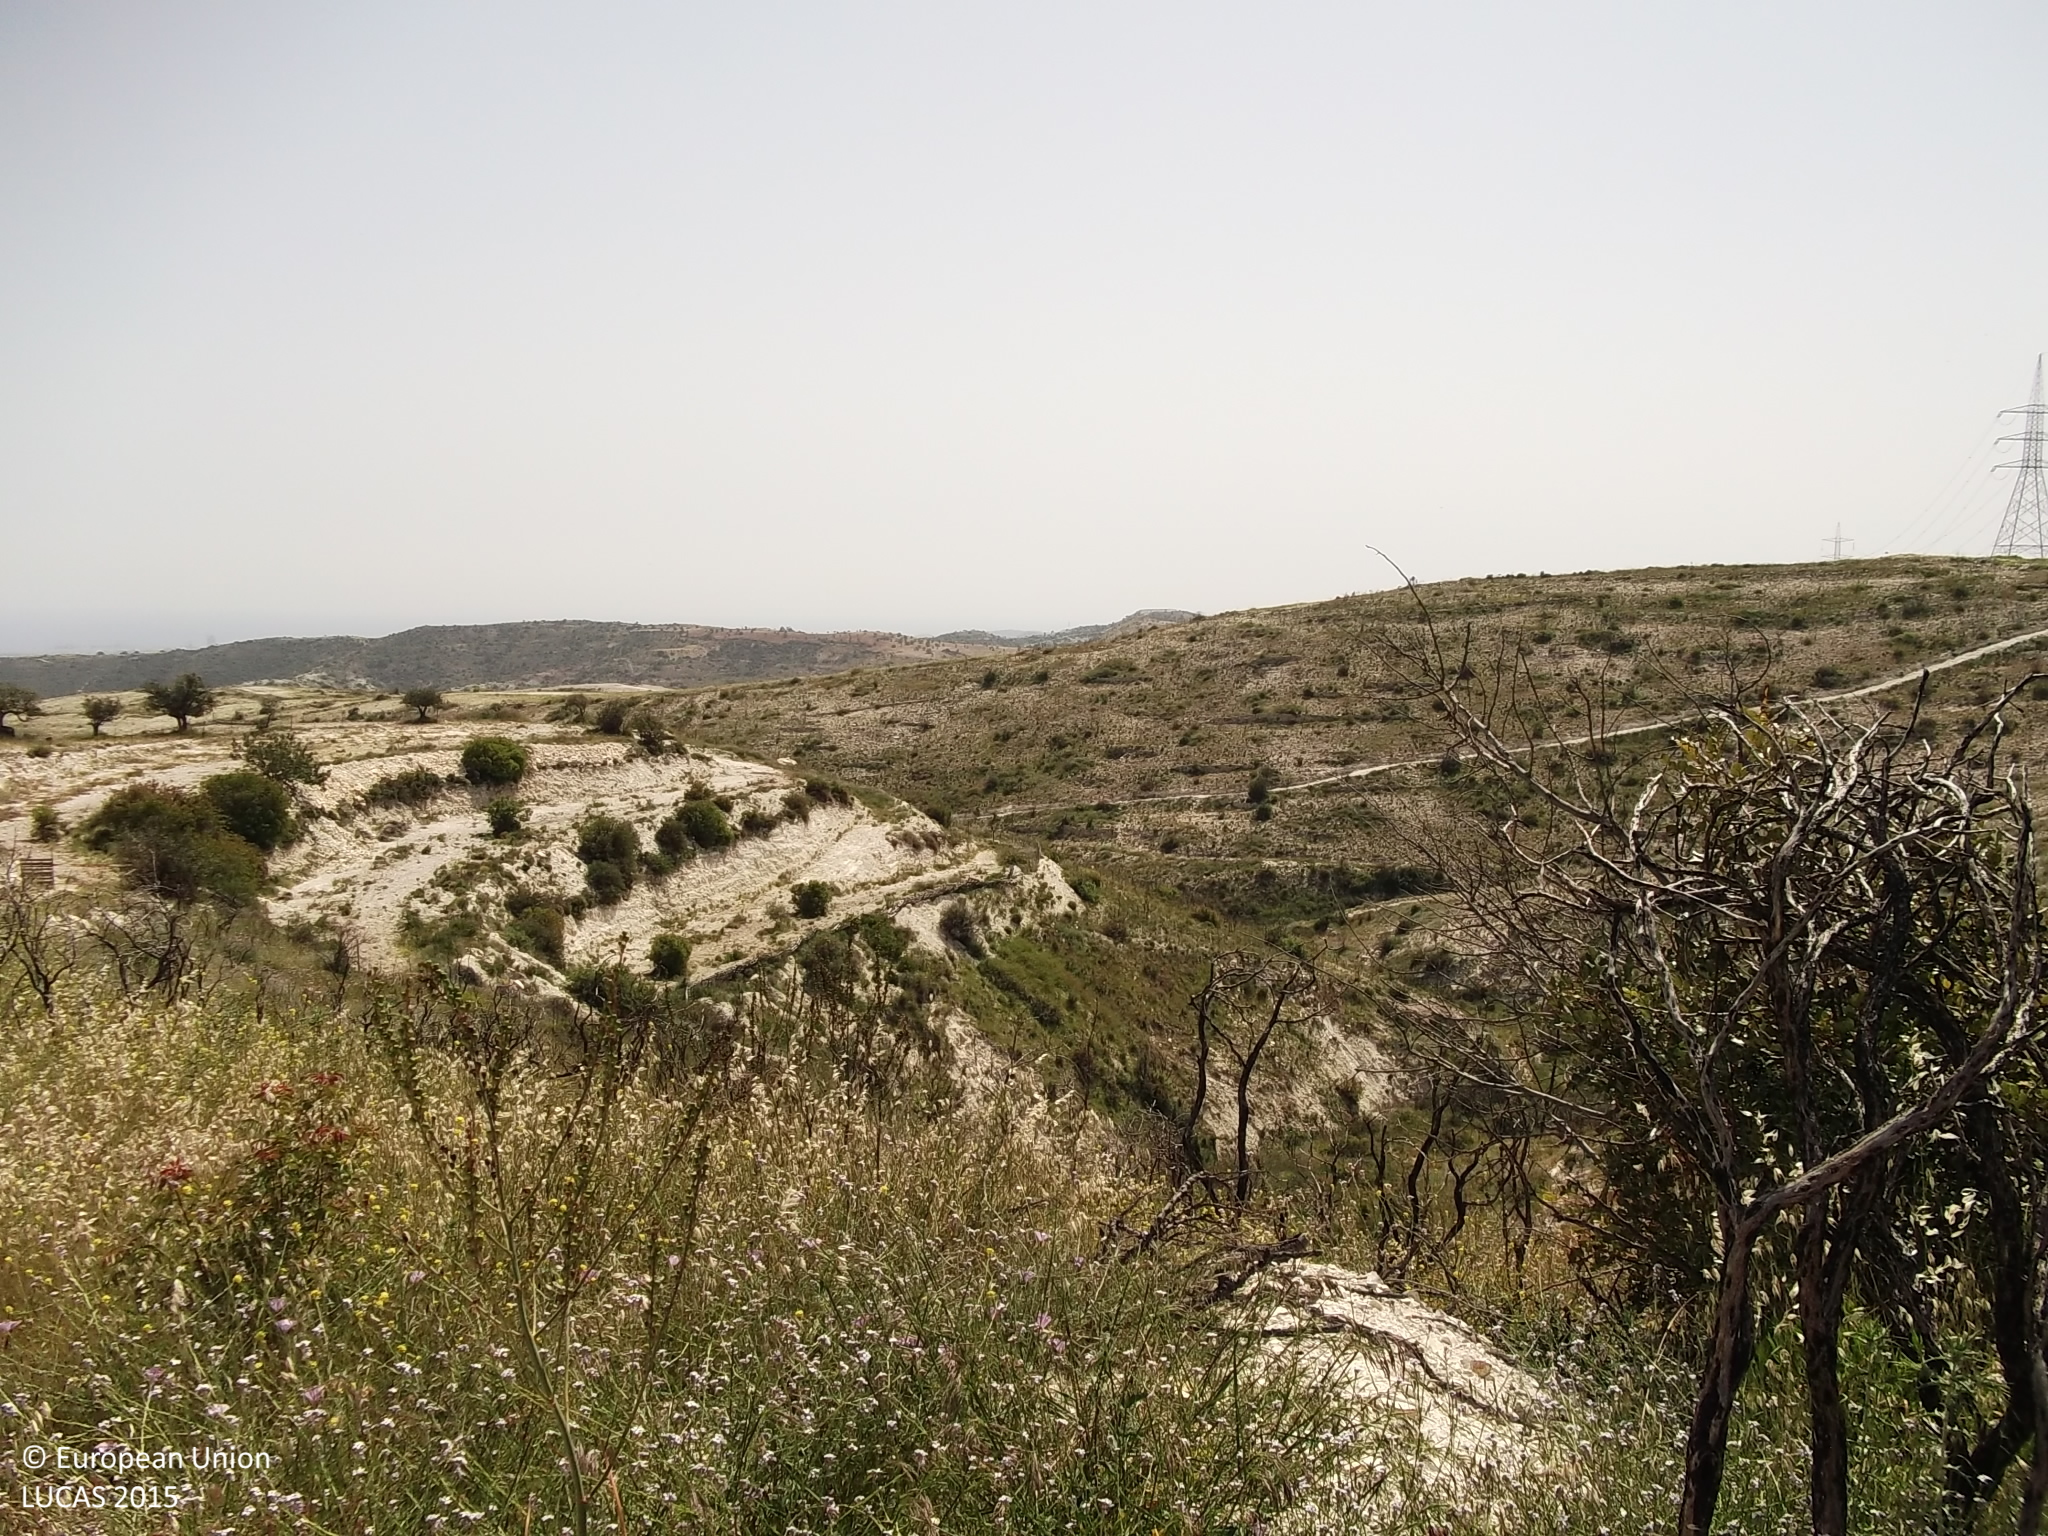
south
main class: Grassland
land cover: Spontaneously vegetated surfaces
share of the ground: 50 - 75 %
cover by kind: herbaceous plants 60 %, unconsolidated bare surface 40 %
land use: Semi-natural and natural areas not in use
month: April
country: CY
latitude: 34.8398
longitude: 33.3320
